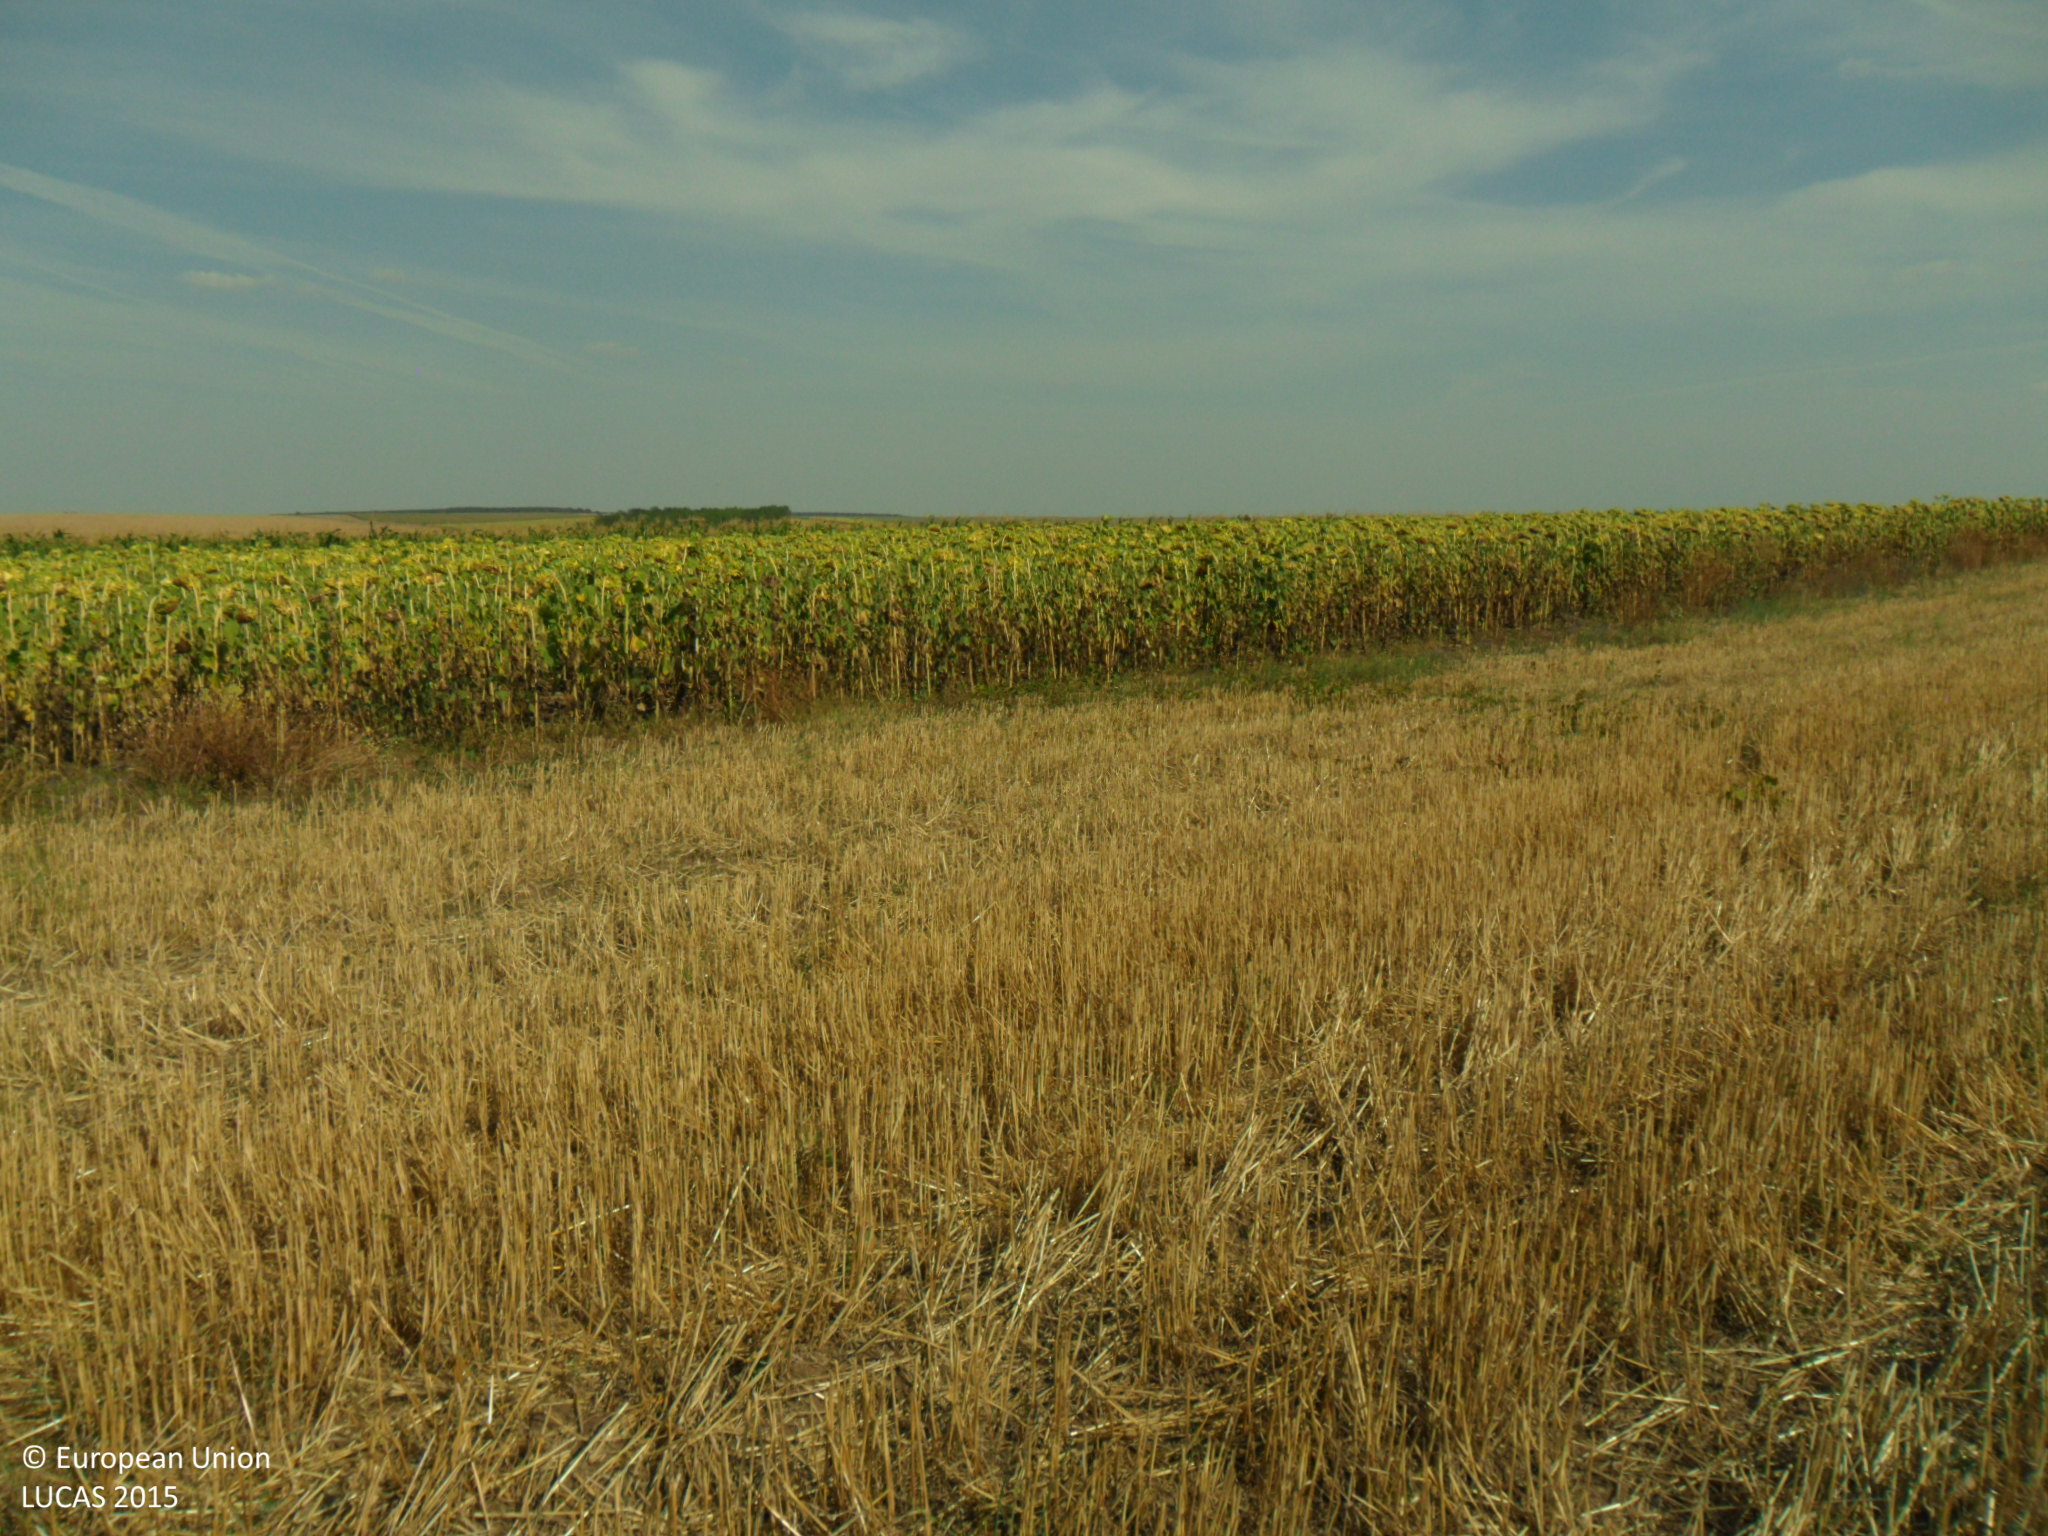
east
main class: Cropland
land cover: Common wheat
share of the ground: 25 - 50 %
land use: Agriculture (excluding fallow land and kitchen gardens)
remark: Harvested field
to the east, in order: Common wheat; Grass margins; Sunflower; Grass margins; Maize; Tracks; Maize; Grass margins; Common wheat
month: August
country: BG
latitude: 43.6428
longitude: 27.1692
